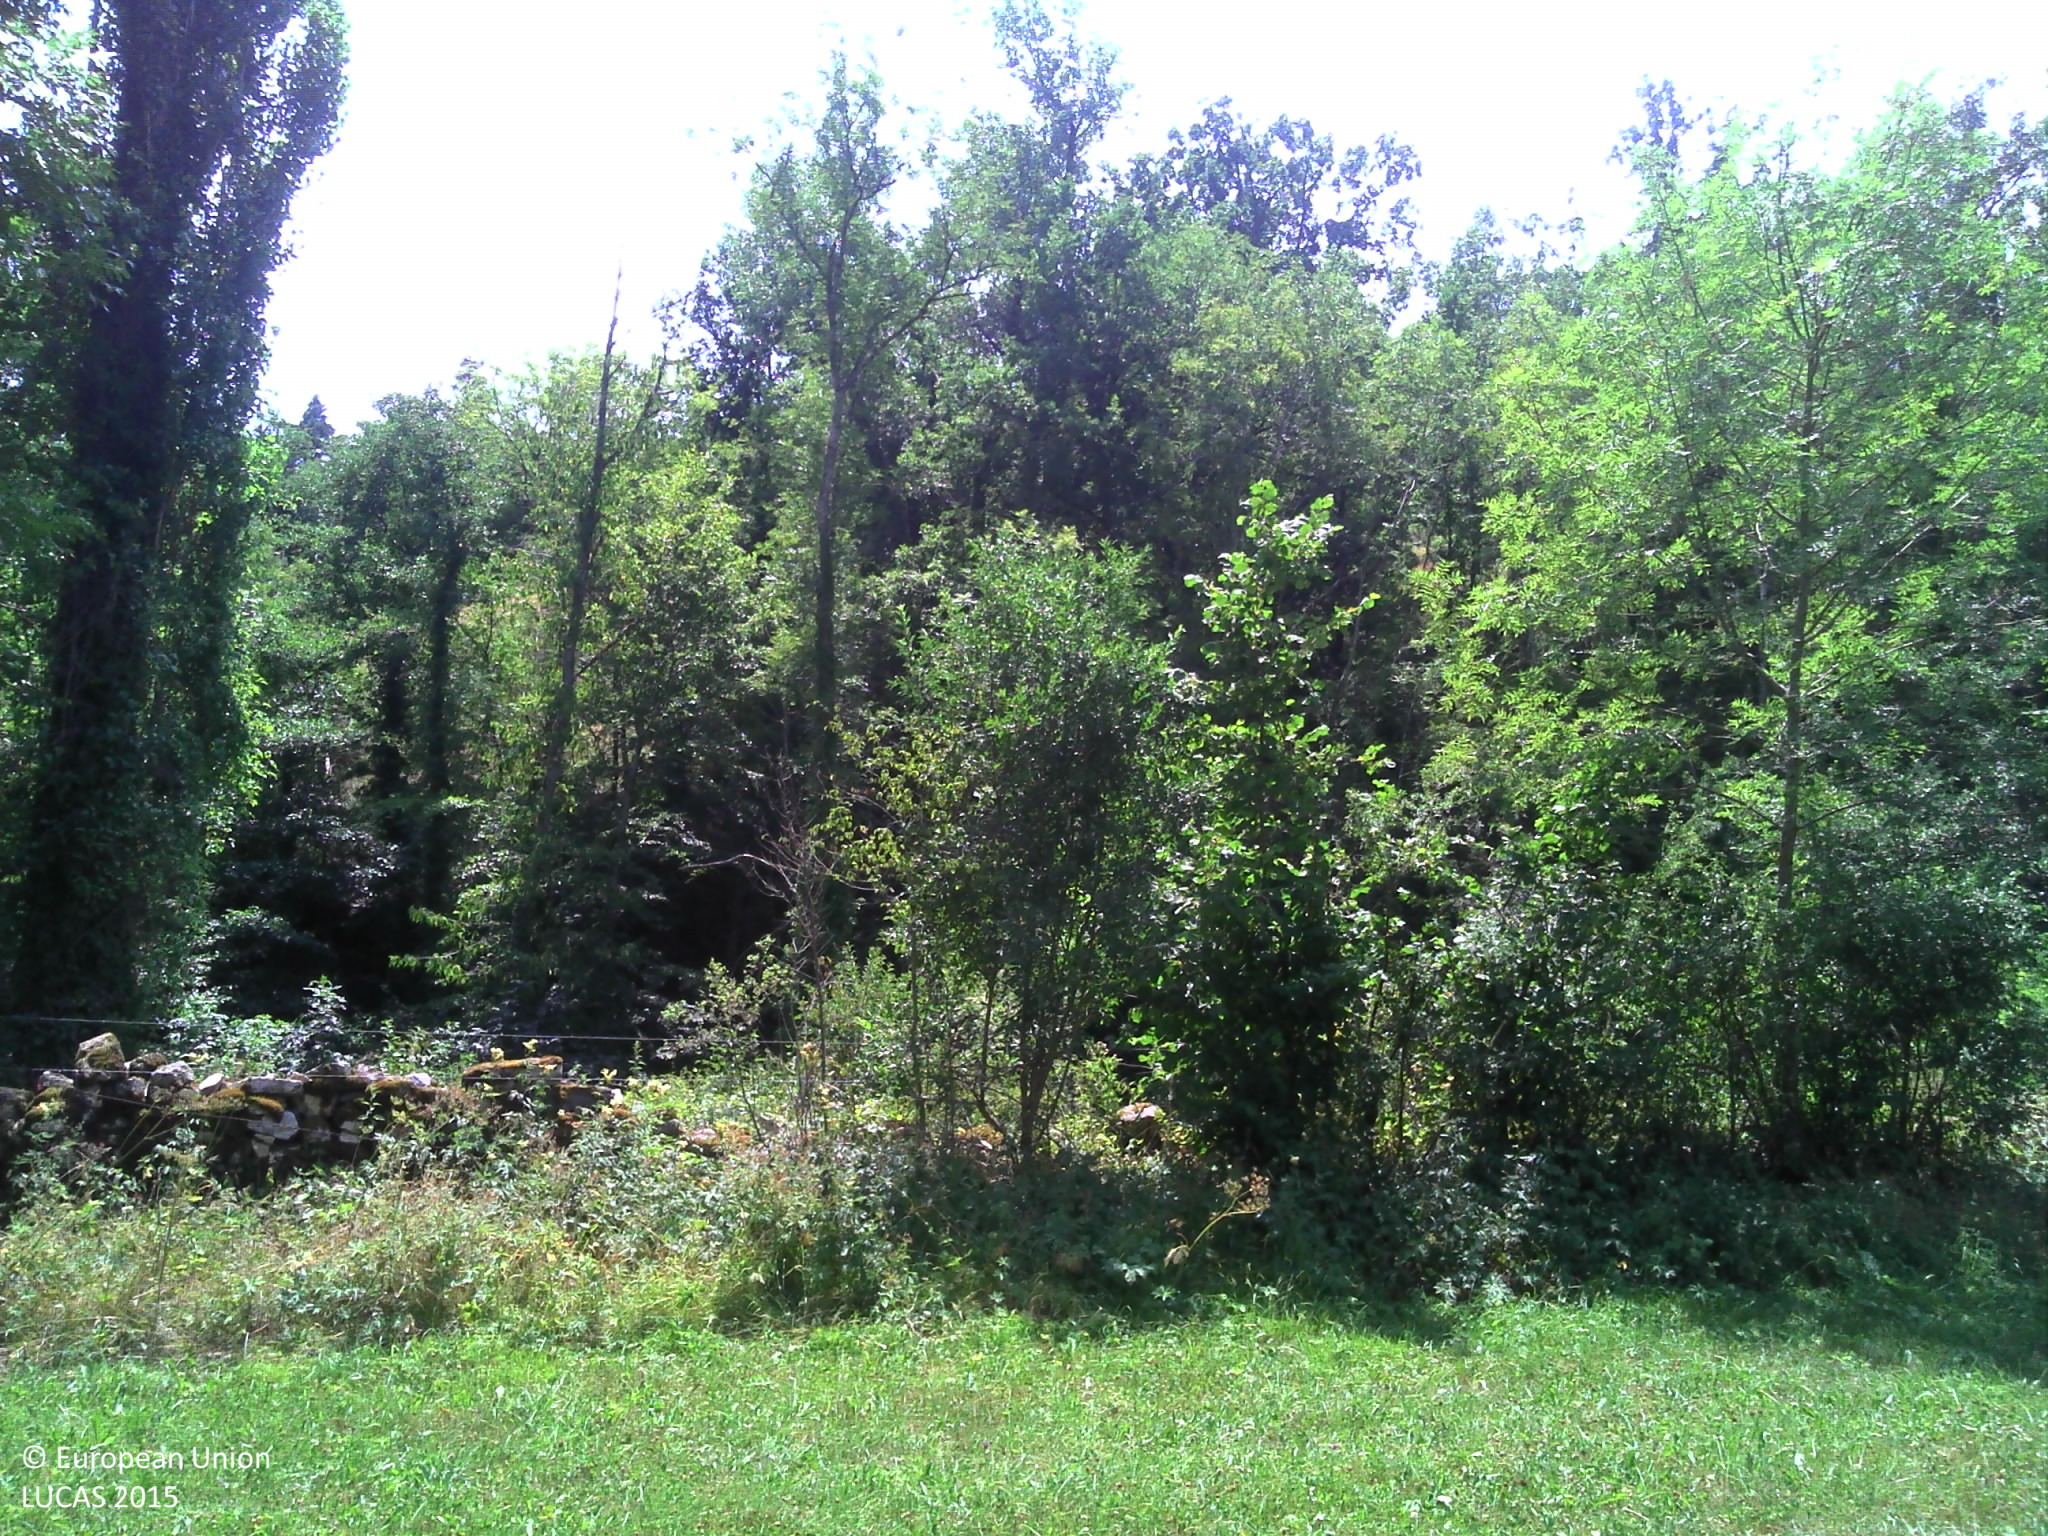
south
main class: Grassland
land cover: Grassland without tree/shrub cover
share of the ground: > 75 %
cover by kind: herbaceous plants 100 %
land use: Agriculture (excluding fallow land and kitchen gardens)
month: July
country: FR
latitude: 44.5481
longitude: 3.2703
